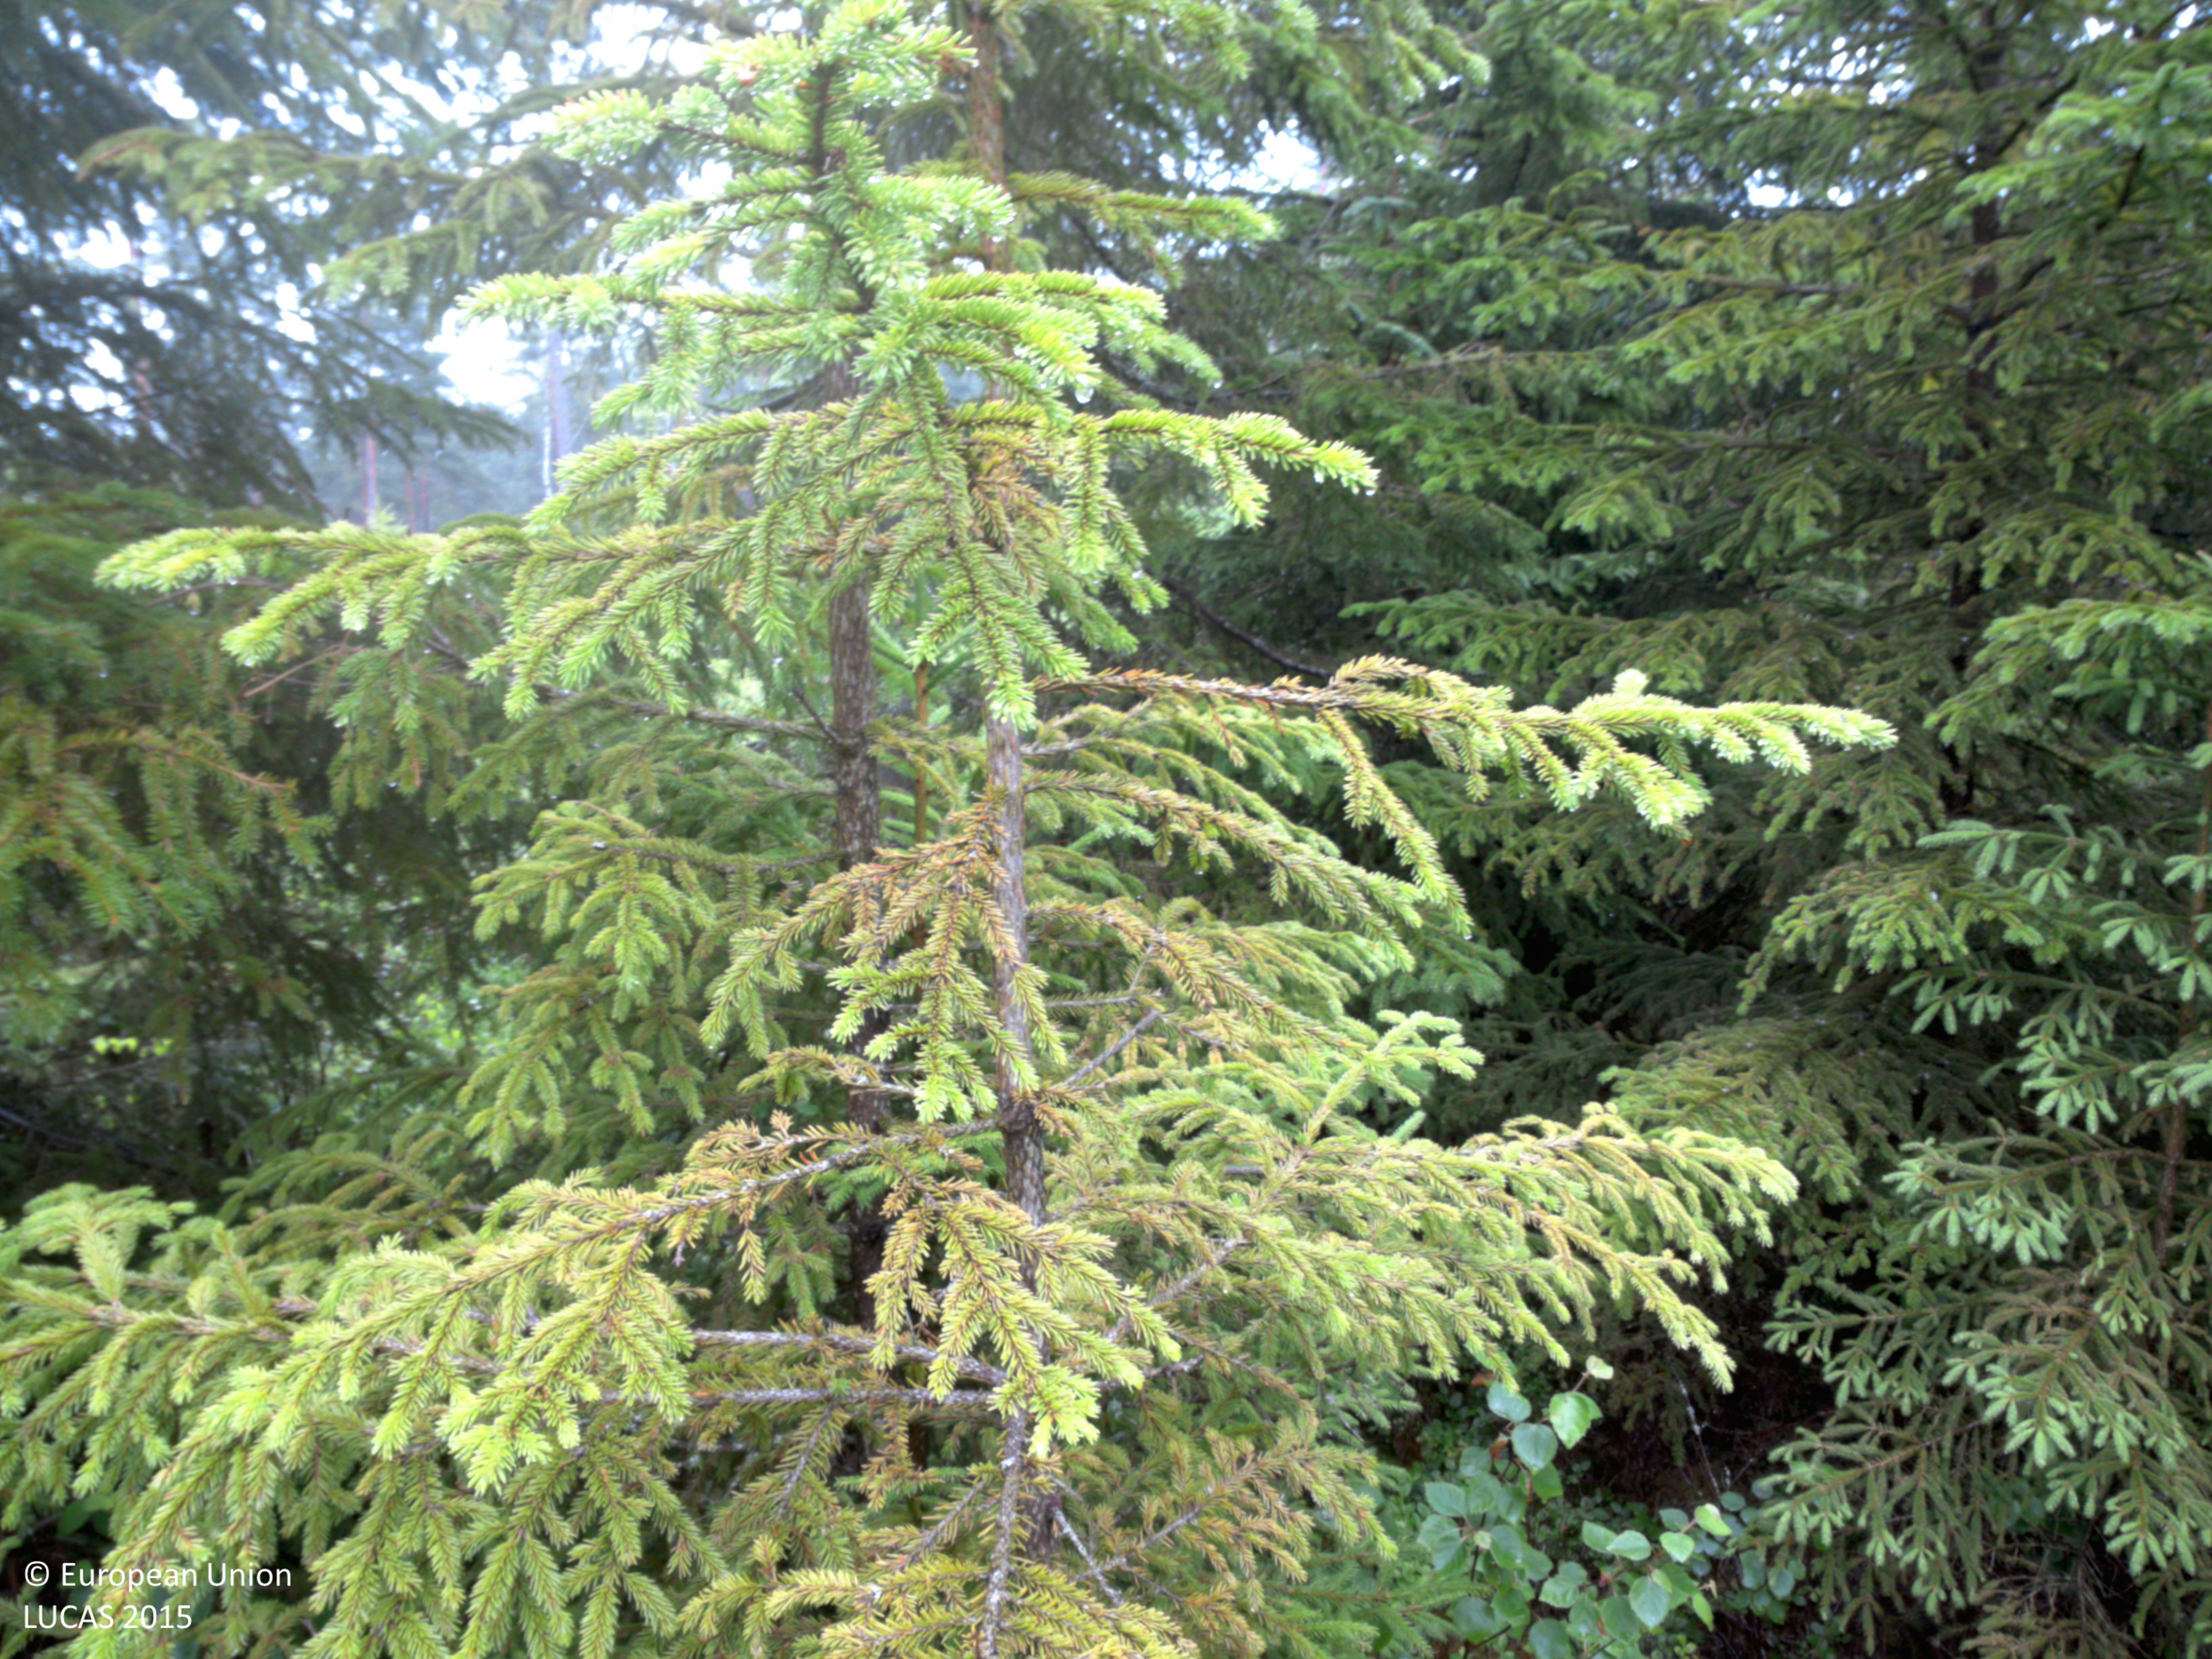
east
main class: Woodland
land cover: Spruce dominated mixed woodland
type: boreal forest
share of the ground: 50 - 75 %
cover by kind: coniferous forest trees 40 %, shrubs 40 %, broadleaved forest trees 20 %
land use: Forestry
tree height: > 5 m
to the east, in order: Spruce dominated mixed woodland; Tracks; Spruce dominated mixed woodland; Pine dominated coniferous woodland
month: July
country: SE
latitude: 58.6597
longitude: 11.5996
